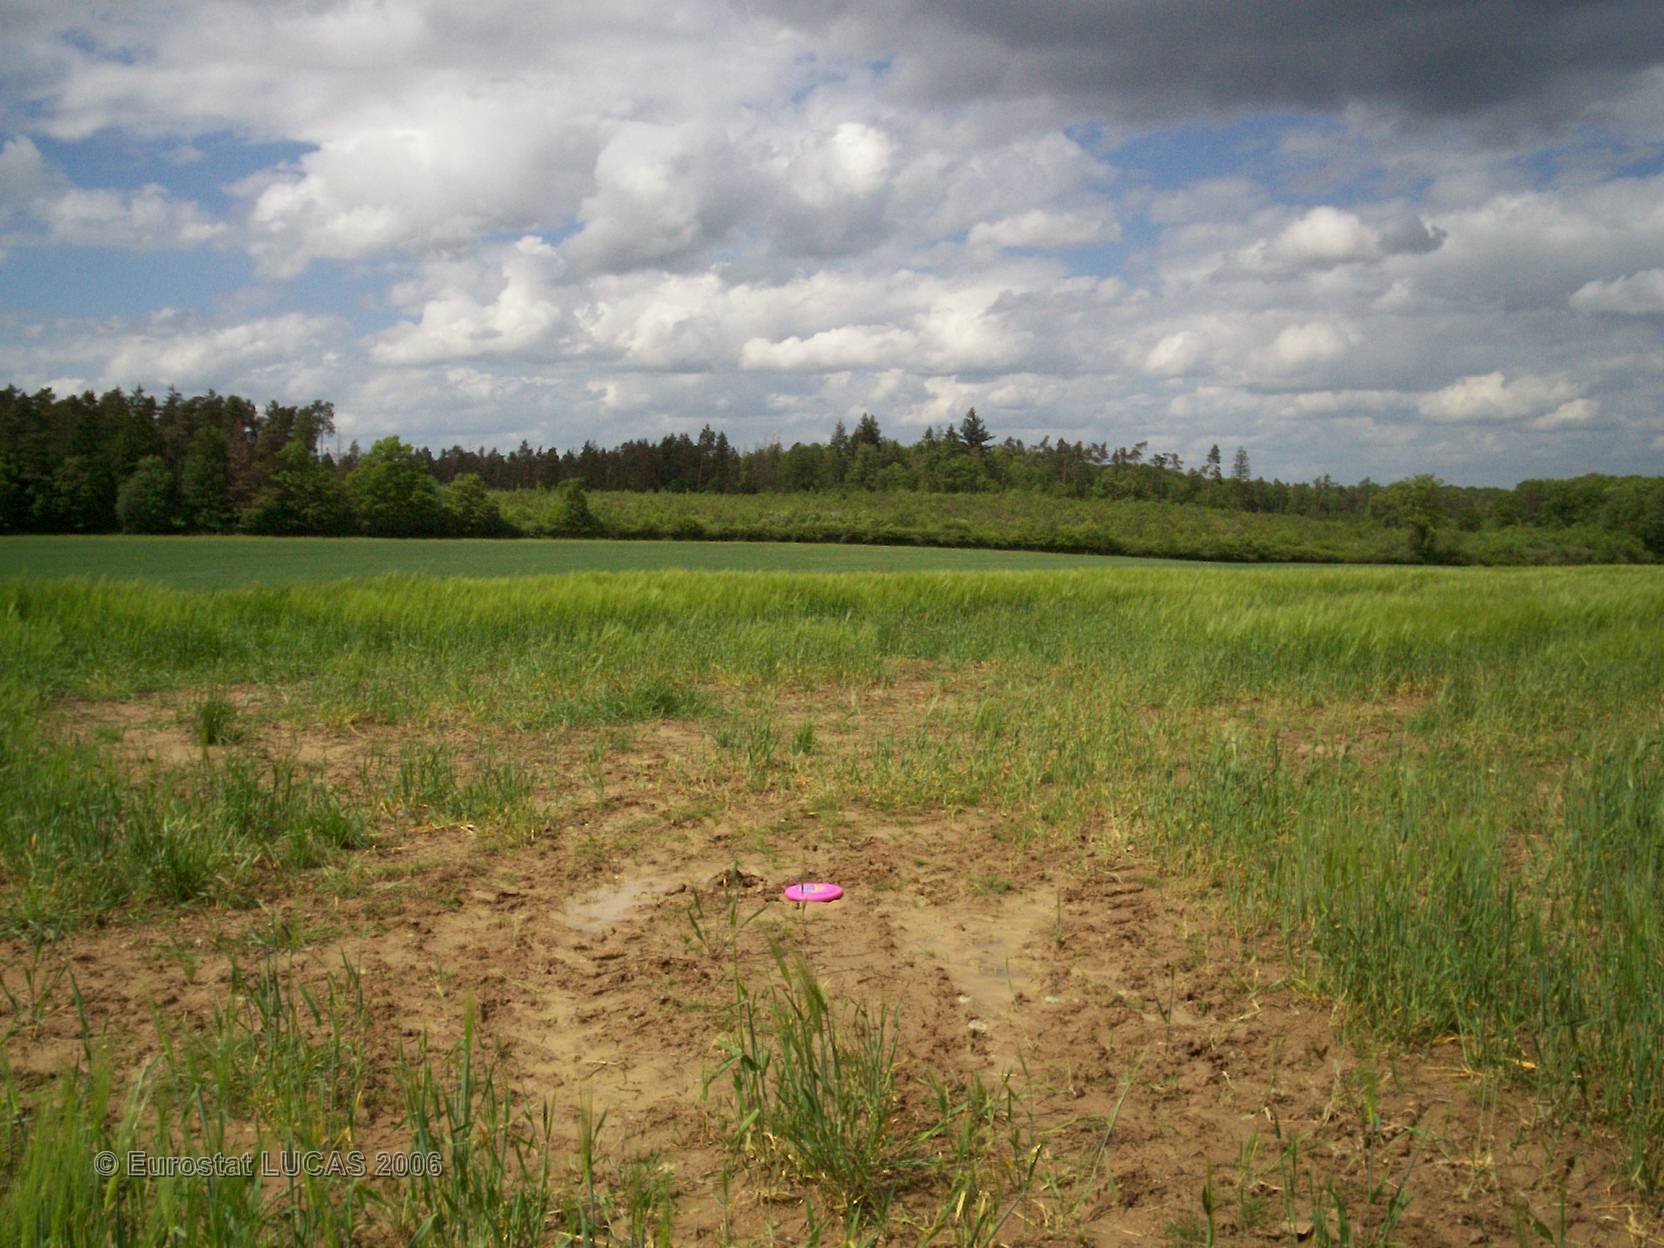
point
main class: Cropland
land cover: Barley
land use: Agriculture (excluding fallow land and kitchen gardens)
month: May
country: FR
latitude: 48.6441
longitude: 6.7567
